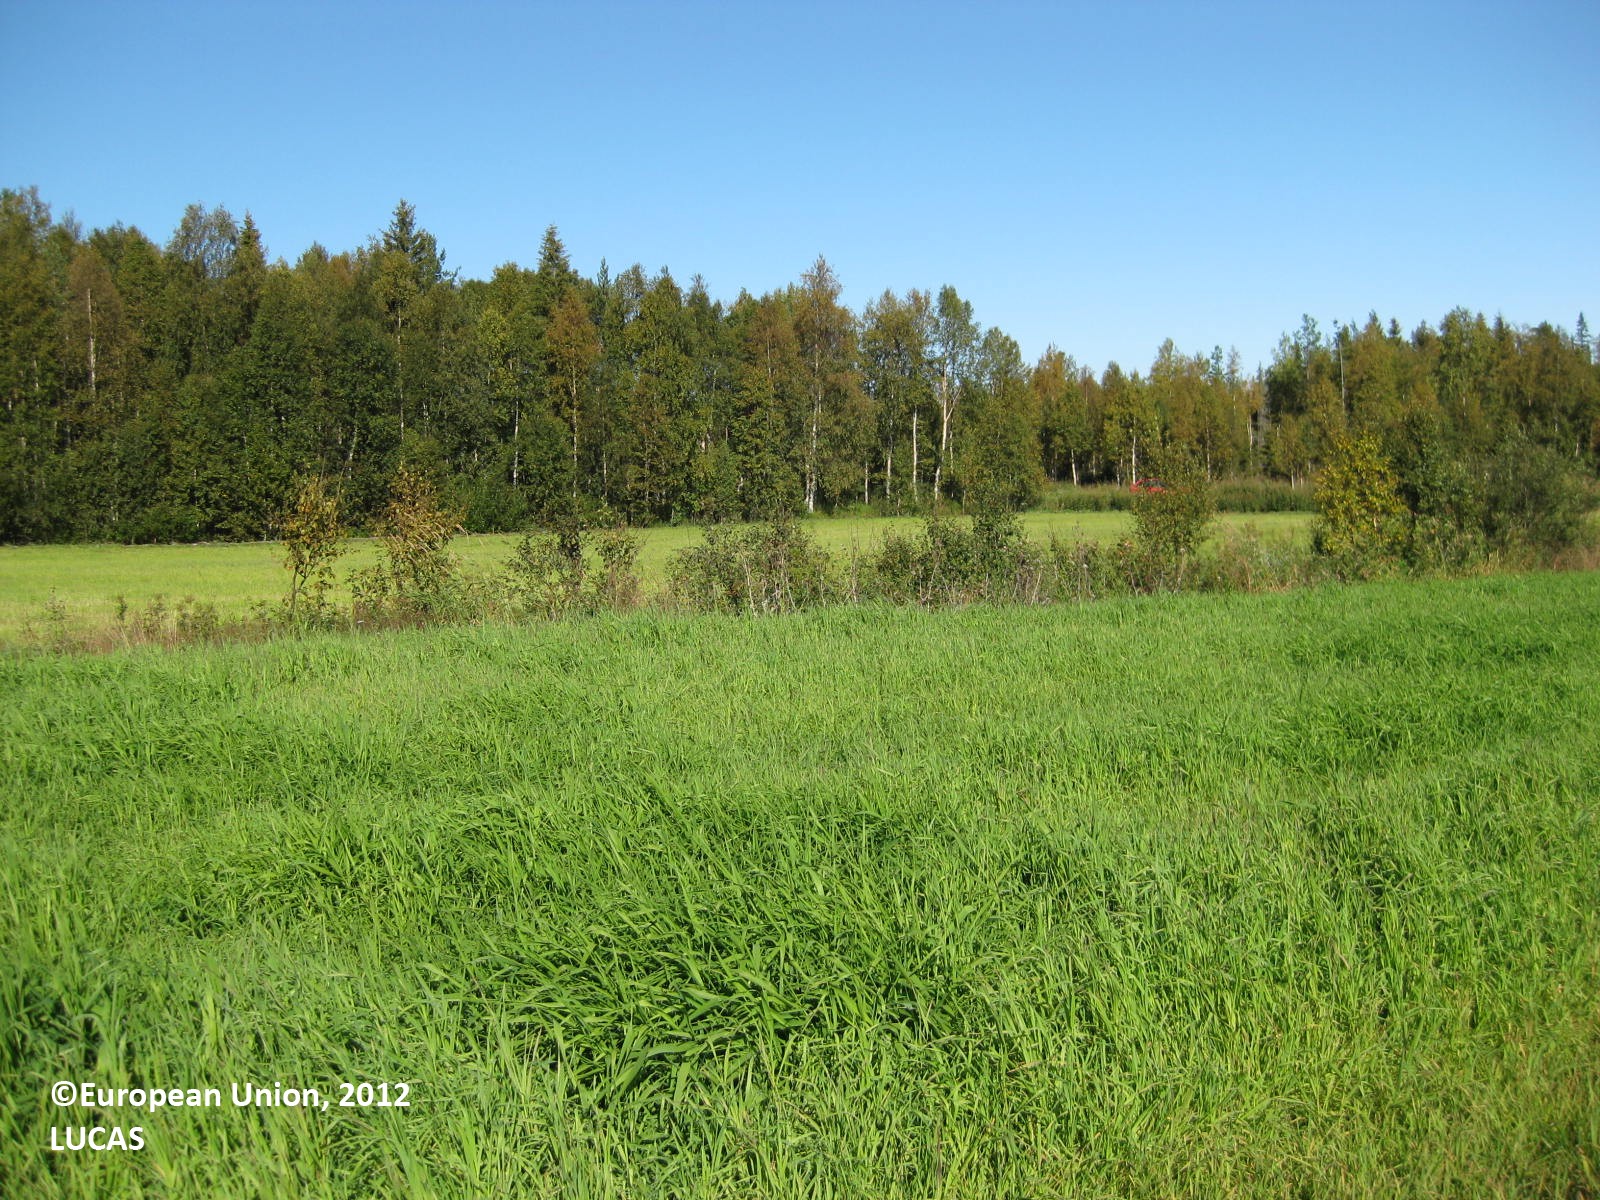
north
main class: Cropland
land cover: Temporary grasslands
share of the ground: > 75 %
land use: Agriculture (excluding fallow land and kitchen gardens)
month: August
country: FI
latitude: 66.0268
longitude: 29.7644
